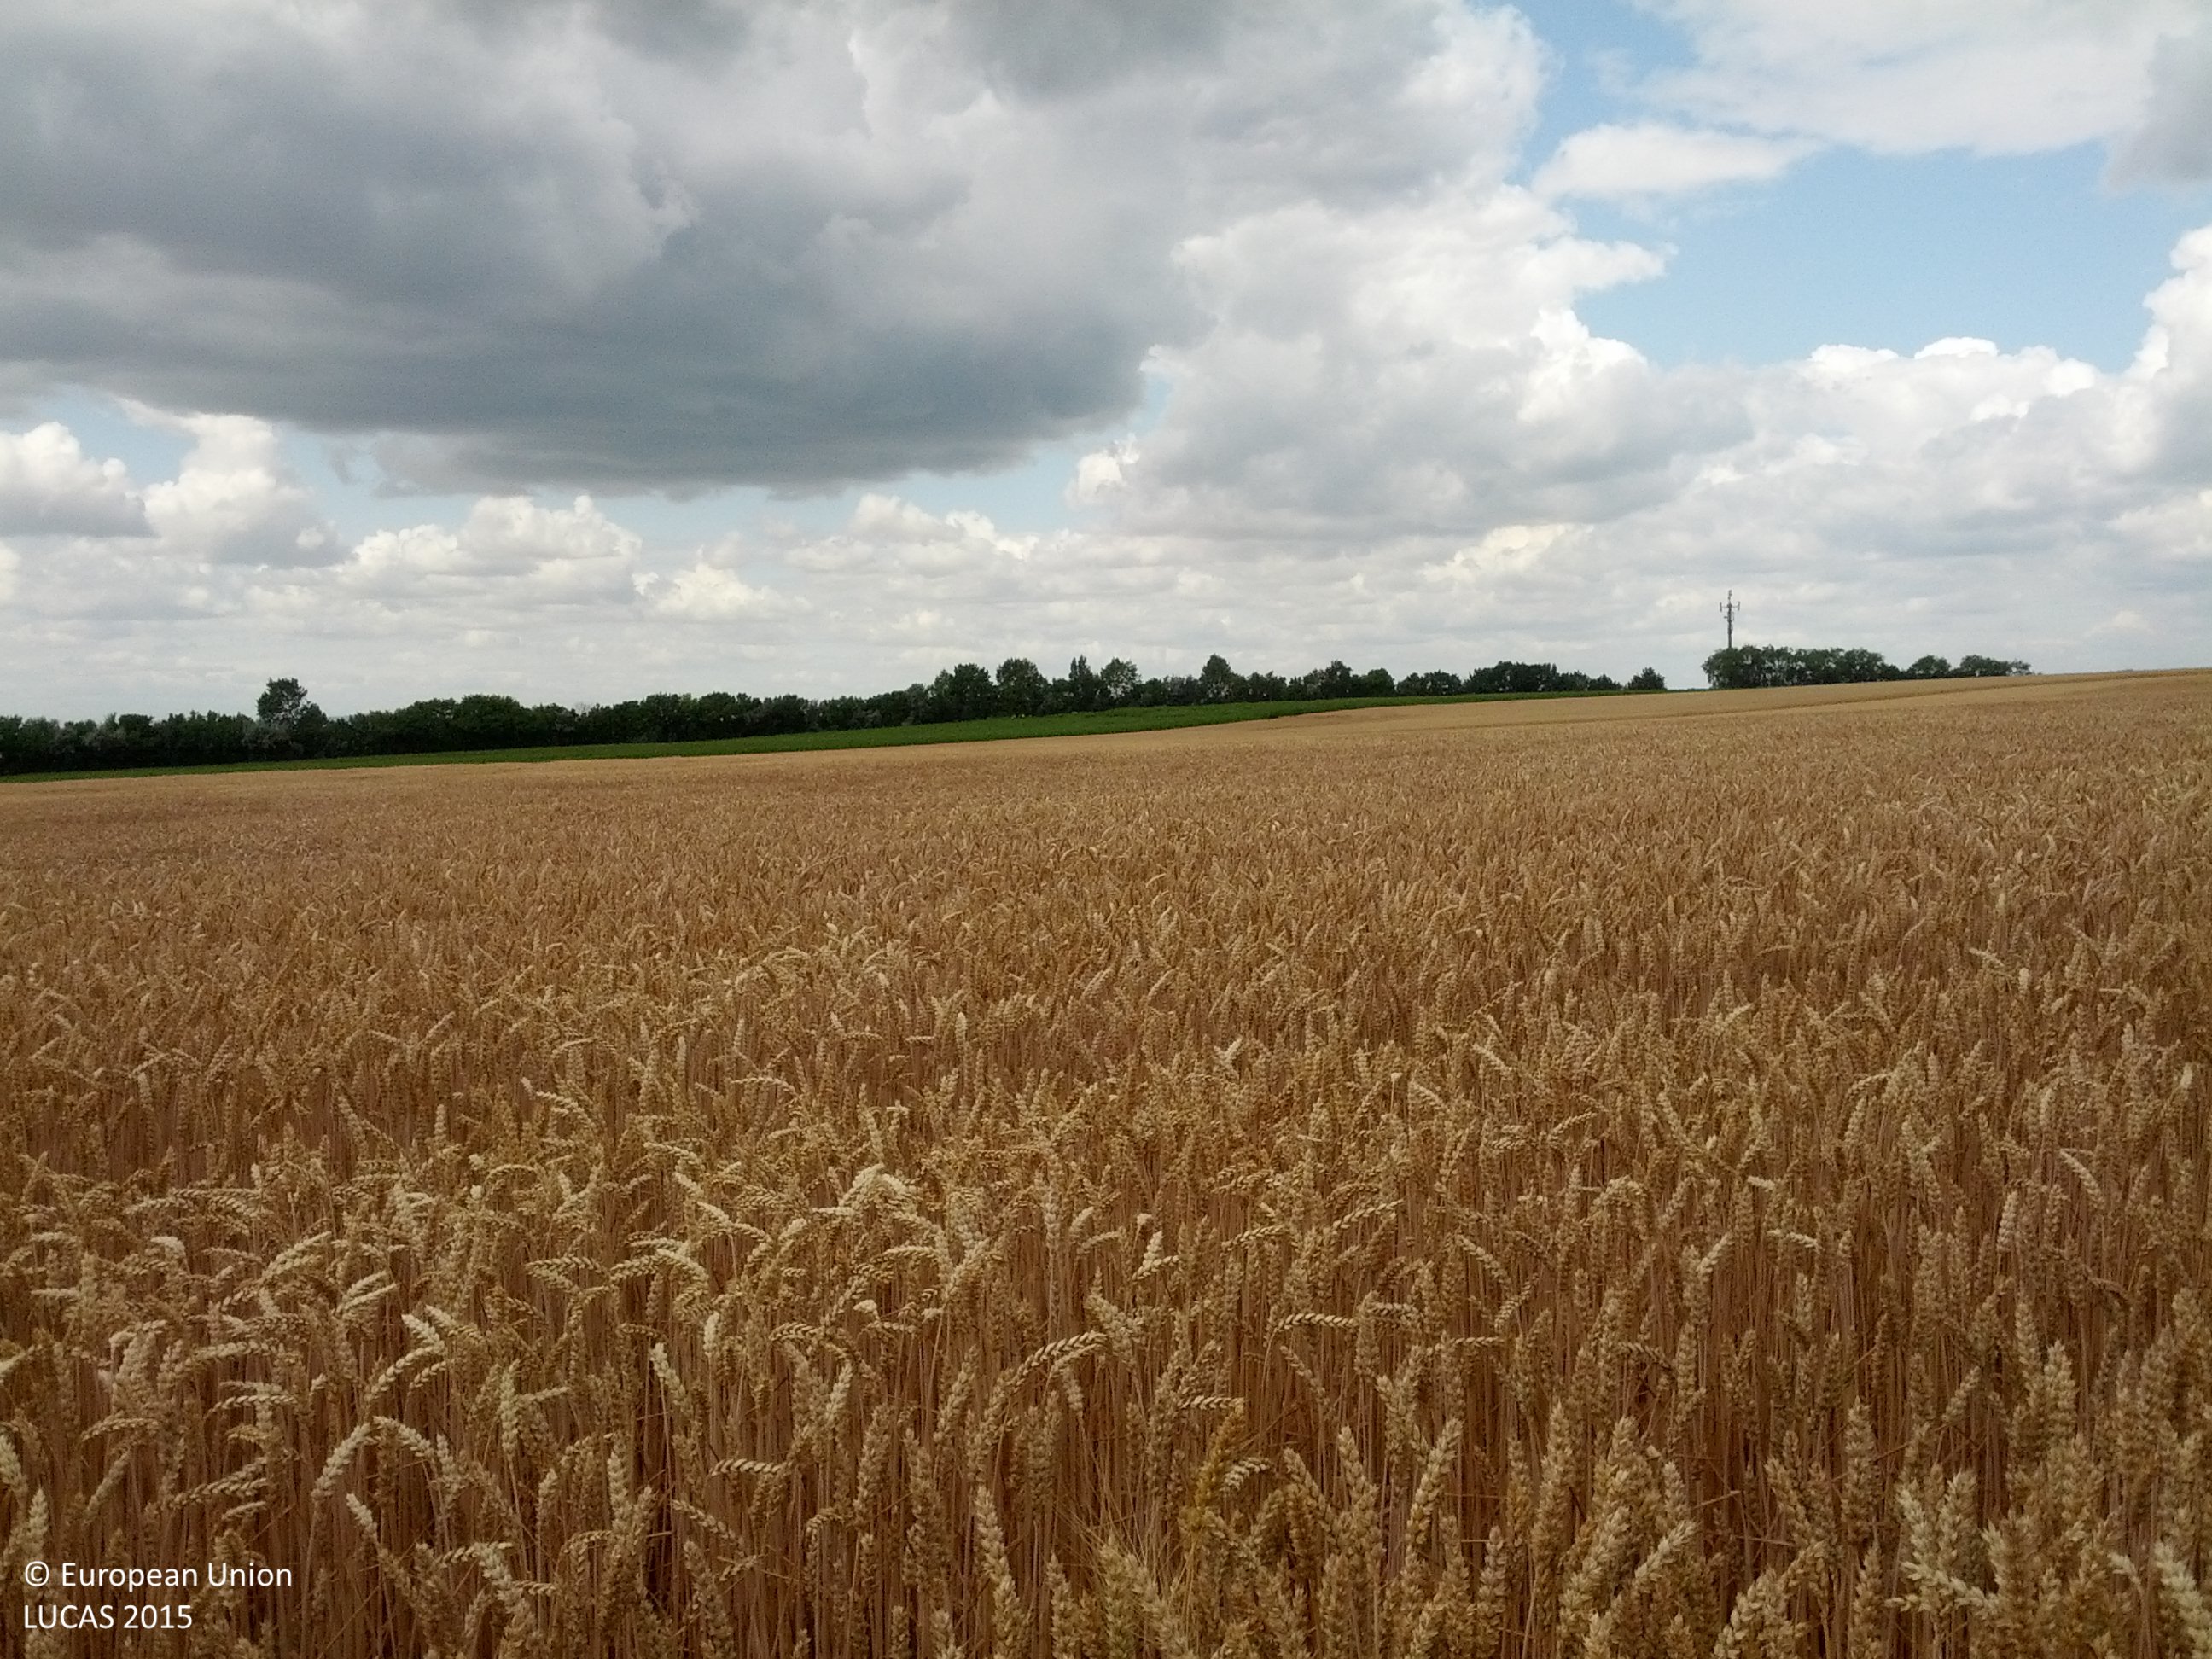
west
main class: Cropland
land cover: Common wheat
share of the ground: > 75 %
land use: Agriculture (excluding fallow land and kitchen gardens)
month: July
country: AT
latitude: 48.7166
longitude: 16.5169
